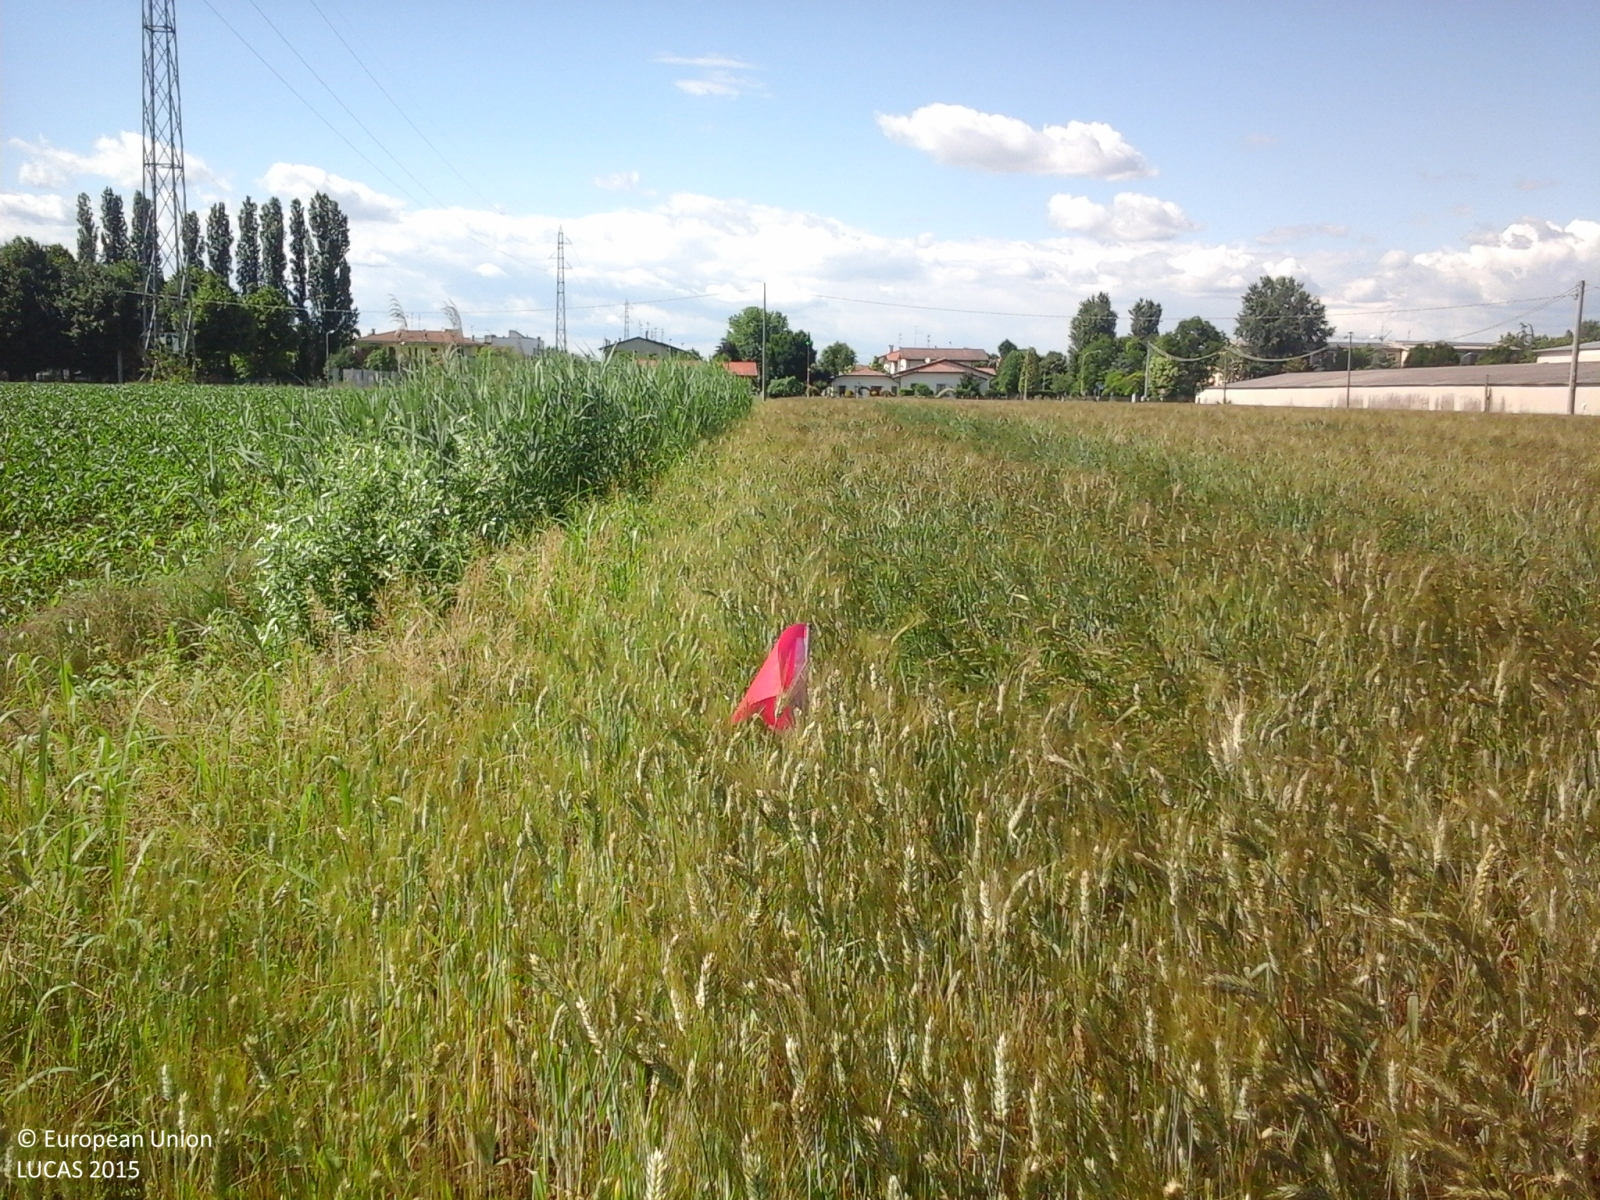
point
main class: Cropland
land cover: Common wheat
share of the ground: > 75 %
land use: Agriculture (excluding fallow land and kitchen gardens)
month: May
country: IT
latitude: 45.1381
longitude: 11.1043
